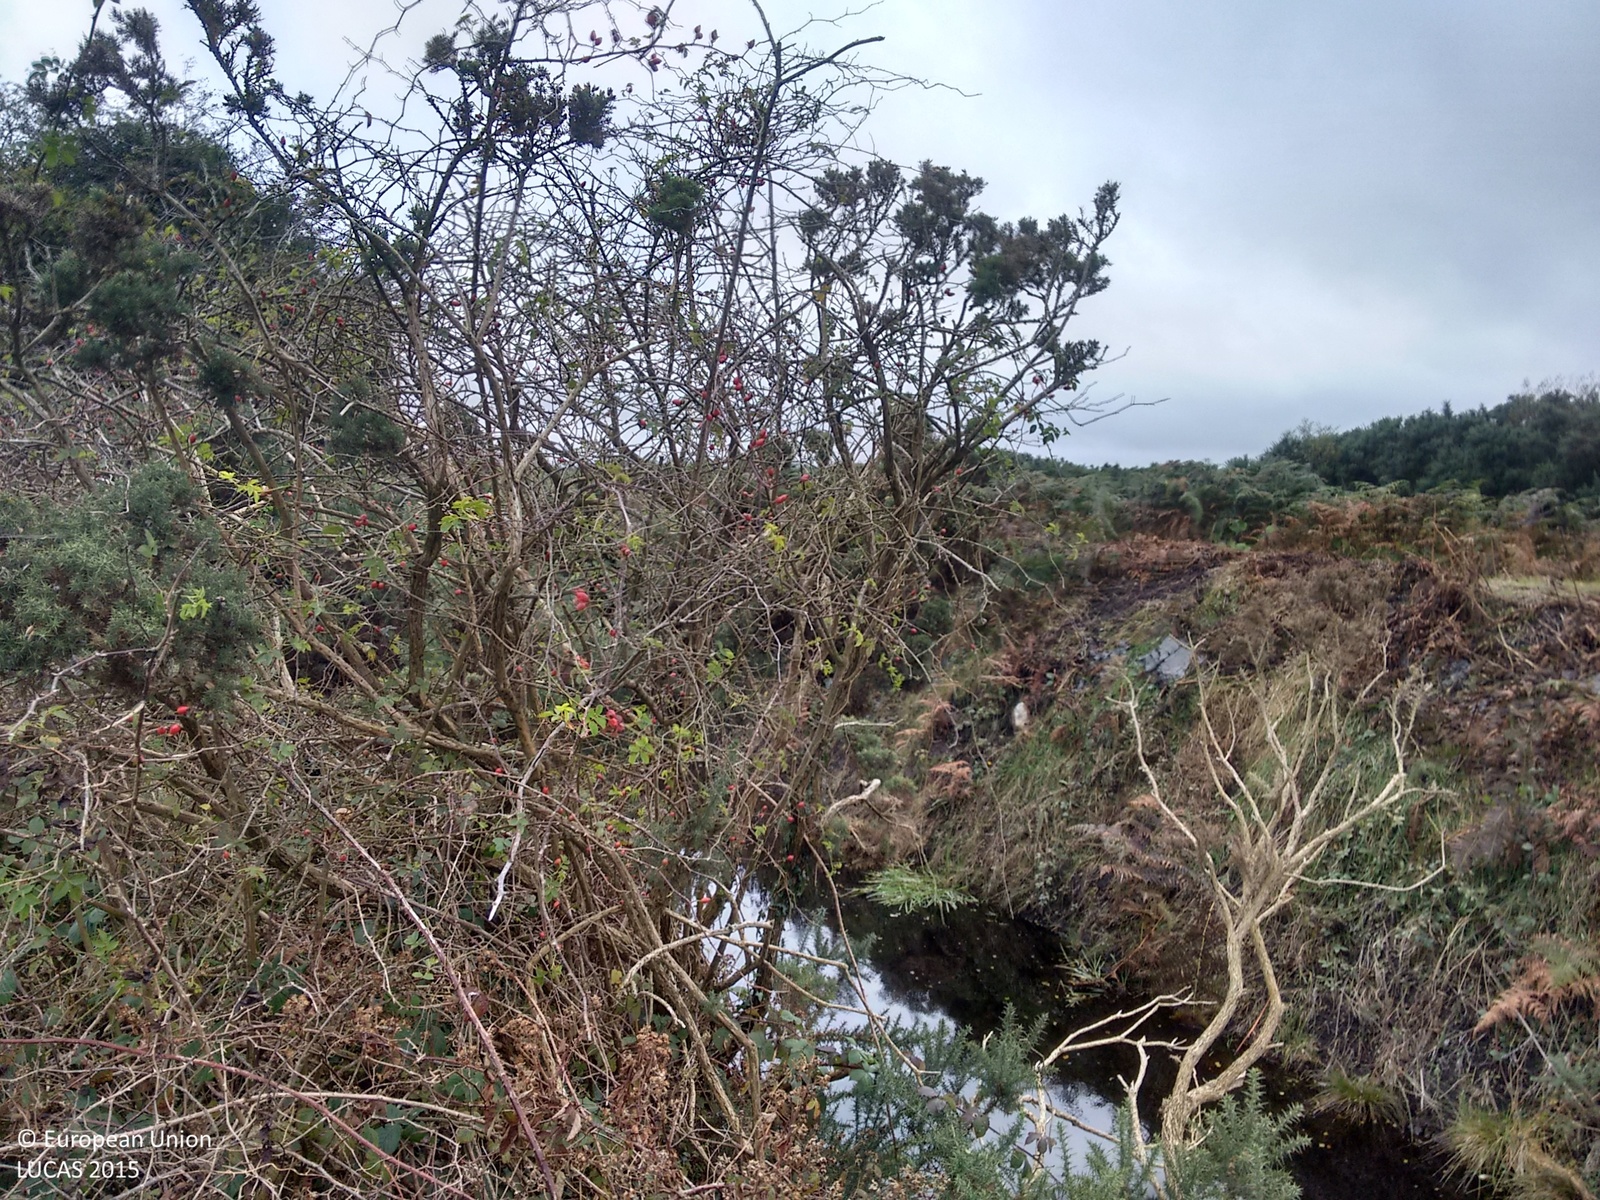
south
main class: Shrubland
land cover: Shrubland with sparse tree cover
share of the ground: > 75 %
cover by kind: shrubs 75 %, herbaceous plants 20 %, broadleaved forest trees 5 %
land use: Semi-natural and natural areas not in use
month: October
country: IE
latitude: 53.1942
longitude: -7.9093
